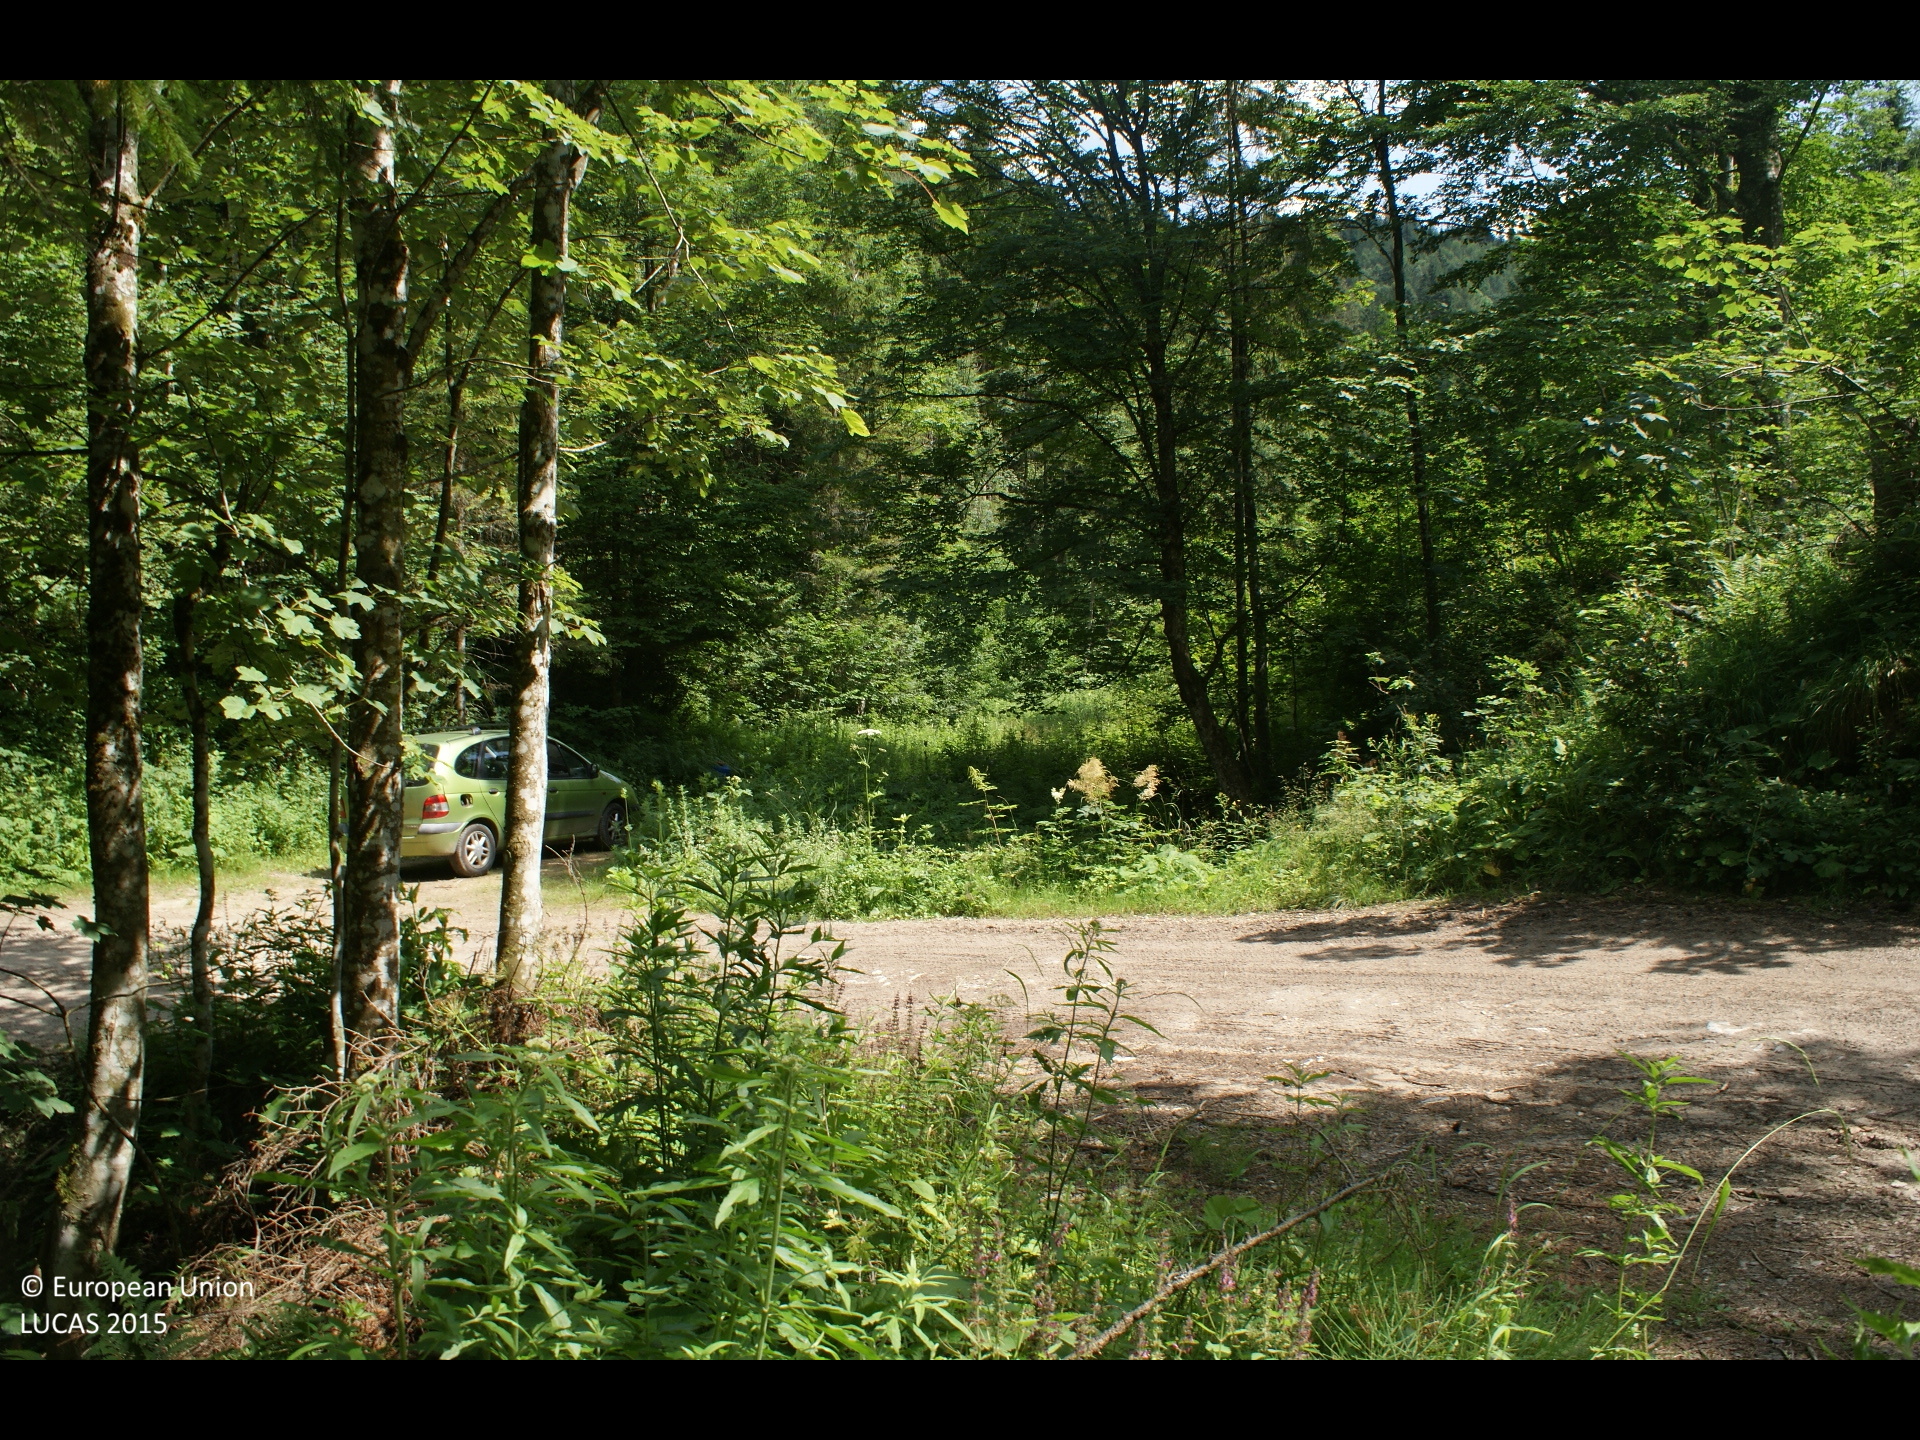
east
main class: Woodland
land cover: Spruce dominated mixed woodland
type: mesophytic deciduous forest
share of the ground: > 75 %
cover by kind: coniferous forest trees 55 %, broadleaved forest trees 30 %, herbaceous plants 10 %, shrubs 5 %
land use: Forestry
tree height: > 5 m
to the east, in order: Spruce dominated mixed woodland; Tracks; Spruce dominated mixed woodland; Grassland without tree/shrub cover; Spruce dominated mixed woodland; Spruce dominated coniferous woodland
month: July
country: AT
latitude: 47.8600
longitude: 15.3345
